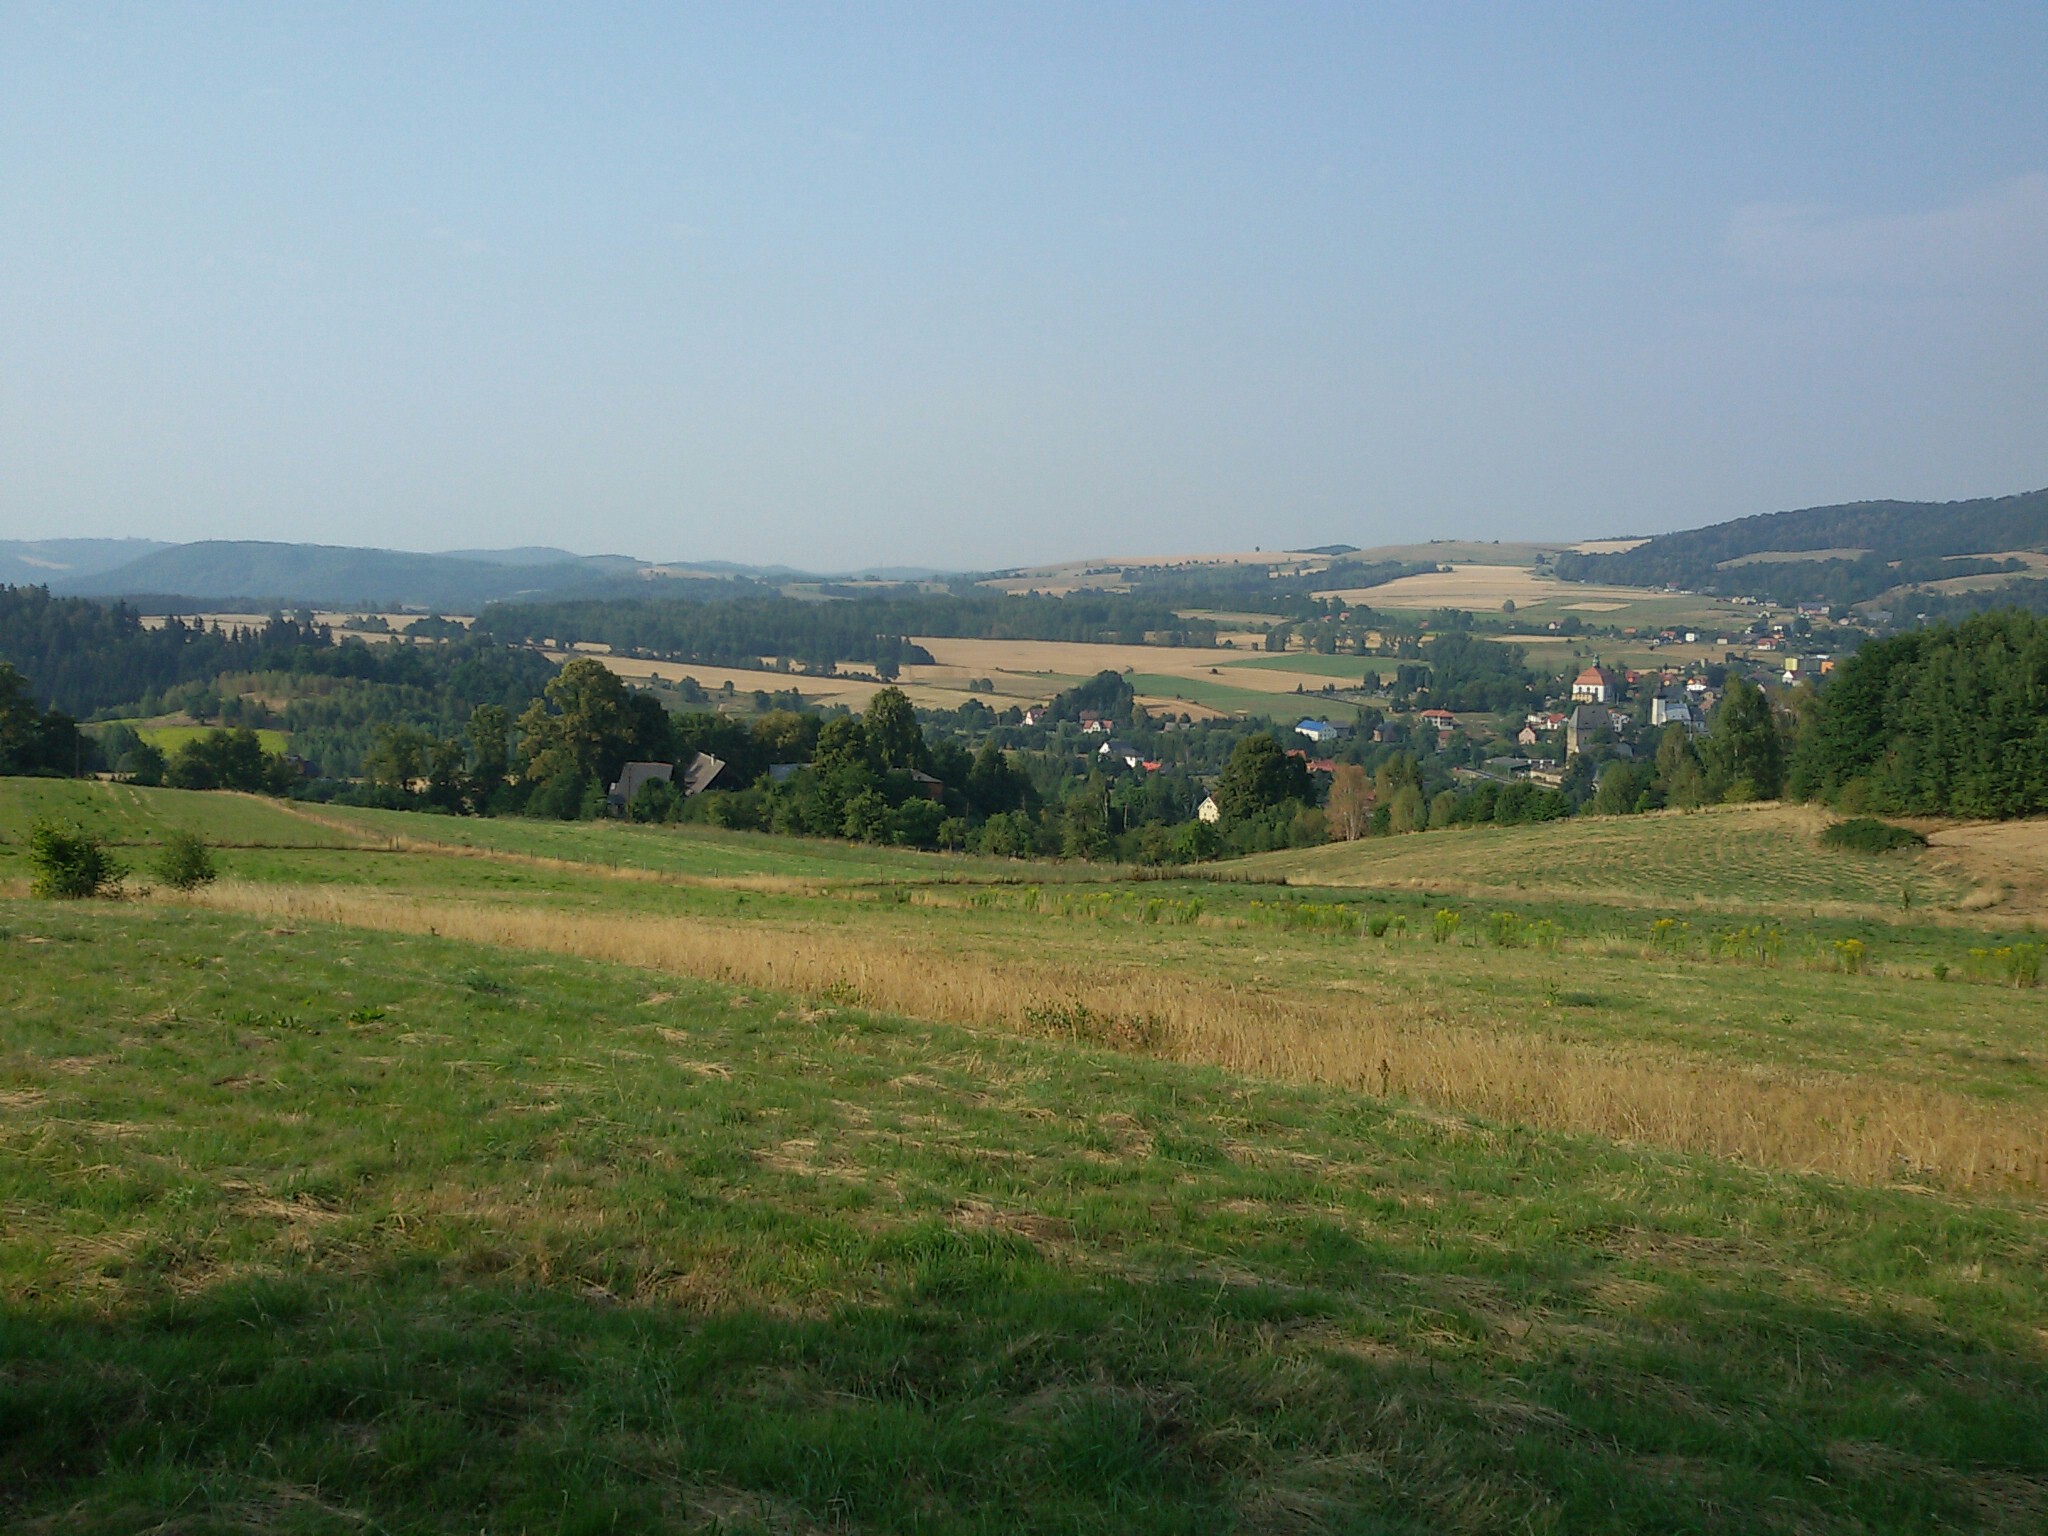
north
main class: Grassland
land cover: Grassland without tree/shrub cover
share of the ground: > 75 %
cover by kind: herbaceous plants 100 %
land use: Agriculture (excluding fallow land and kitchen gardens)
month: August
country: PL
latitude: 50.9259
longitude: 15.6814
